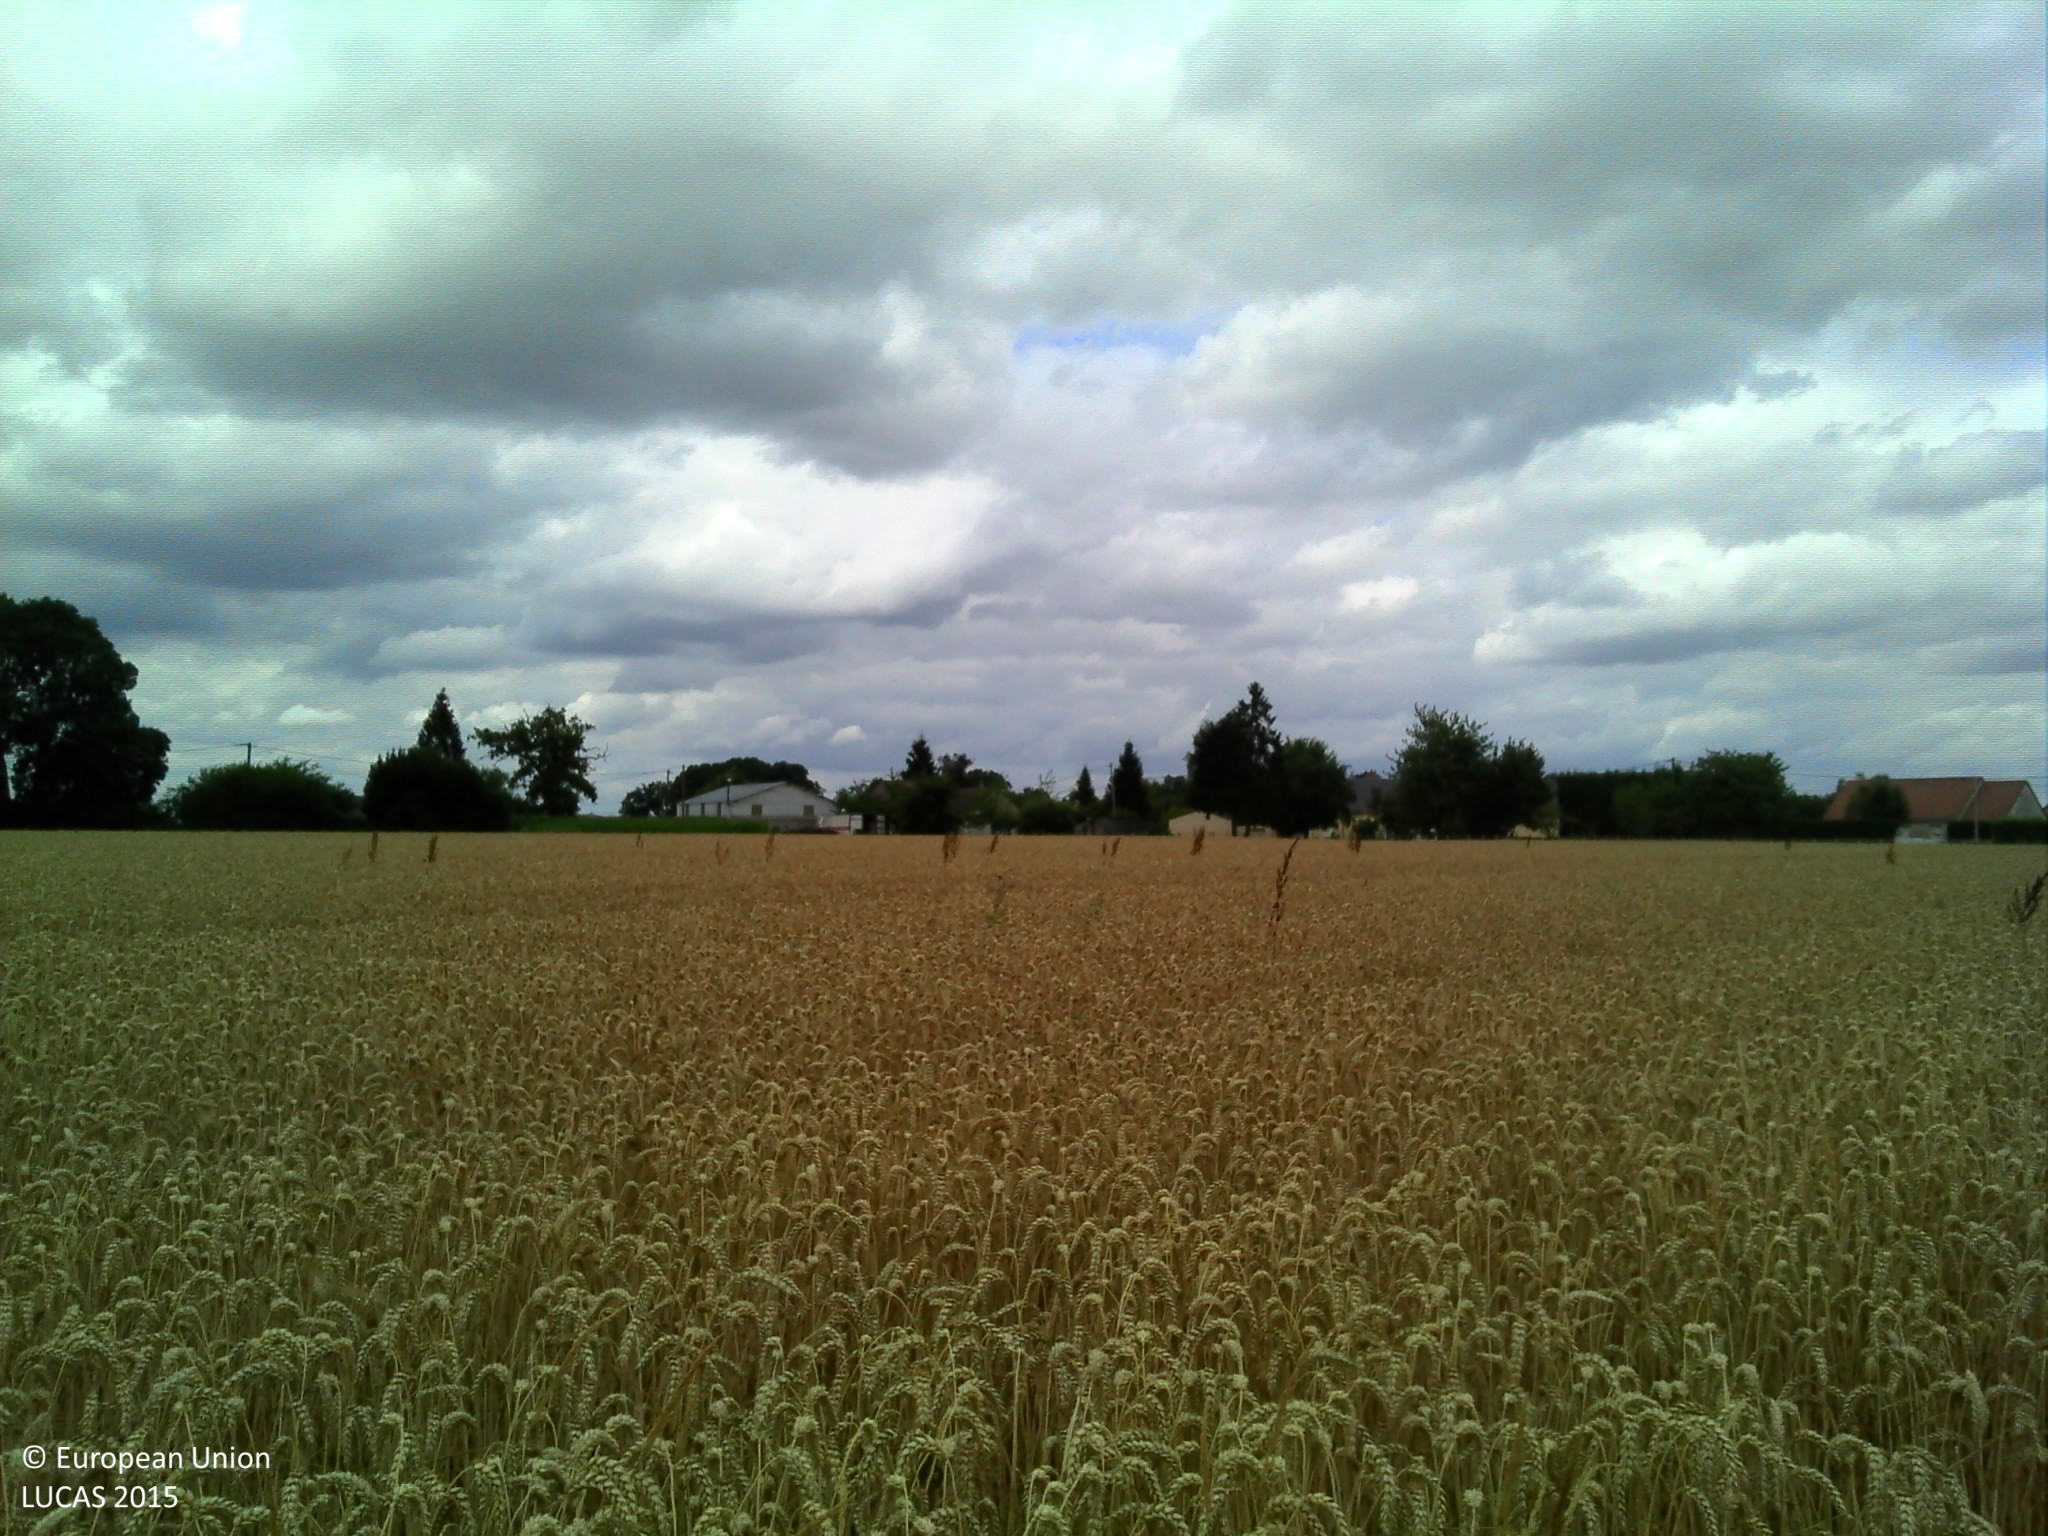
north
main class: Cropland
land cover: Common wheat
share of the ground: > 75 %
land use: Agriculture (excluding fallow land and kitchen gardens)
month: July
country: FR
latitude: 47.7171
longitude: 0.4462
